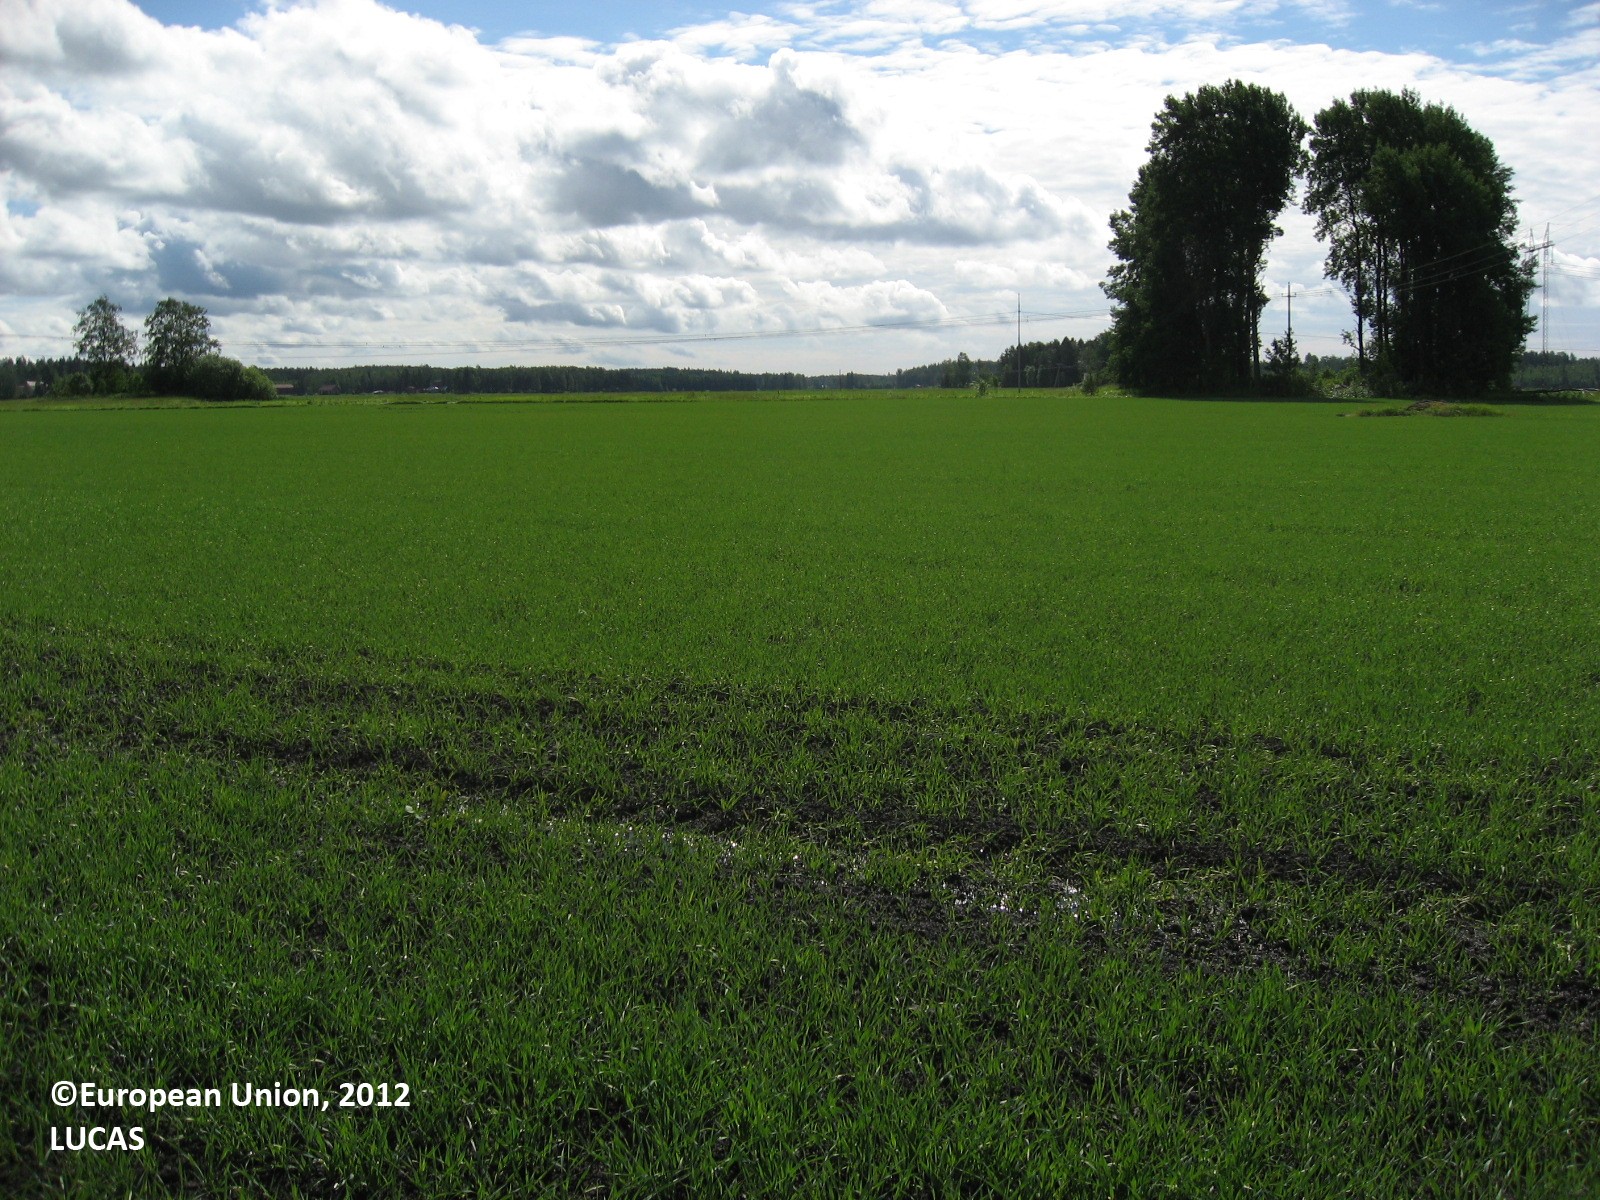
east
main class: Cropland
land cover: Barley
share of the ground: 50 - 75 %
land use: Agriculture (excluding fallow land and kitchen gardens)
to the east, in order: Barley; Broadleaved woodland; Electric lines; Spontaneously vegetated surfaces; Barley; Grass margins; Paved roads, cycling and walking lanes; Grass margins; Ditches and canals; Grass margins; Barley
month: June
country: FI
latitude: 60.5789
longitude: 26.3760
